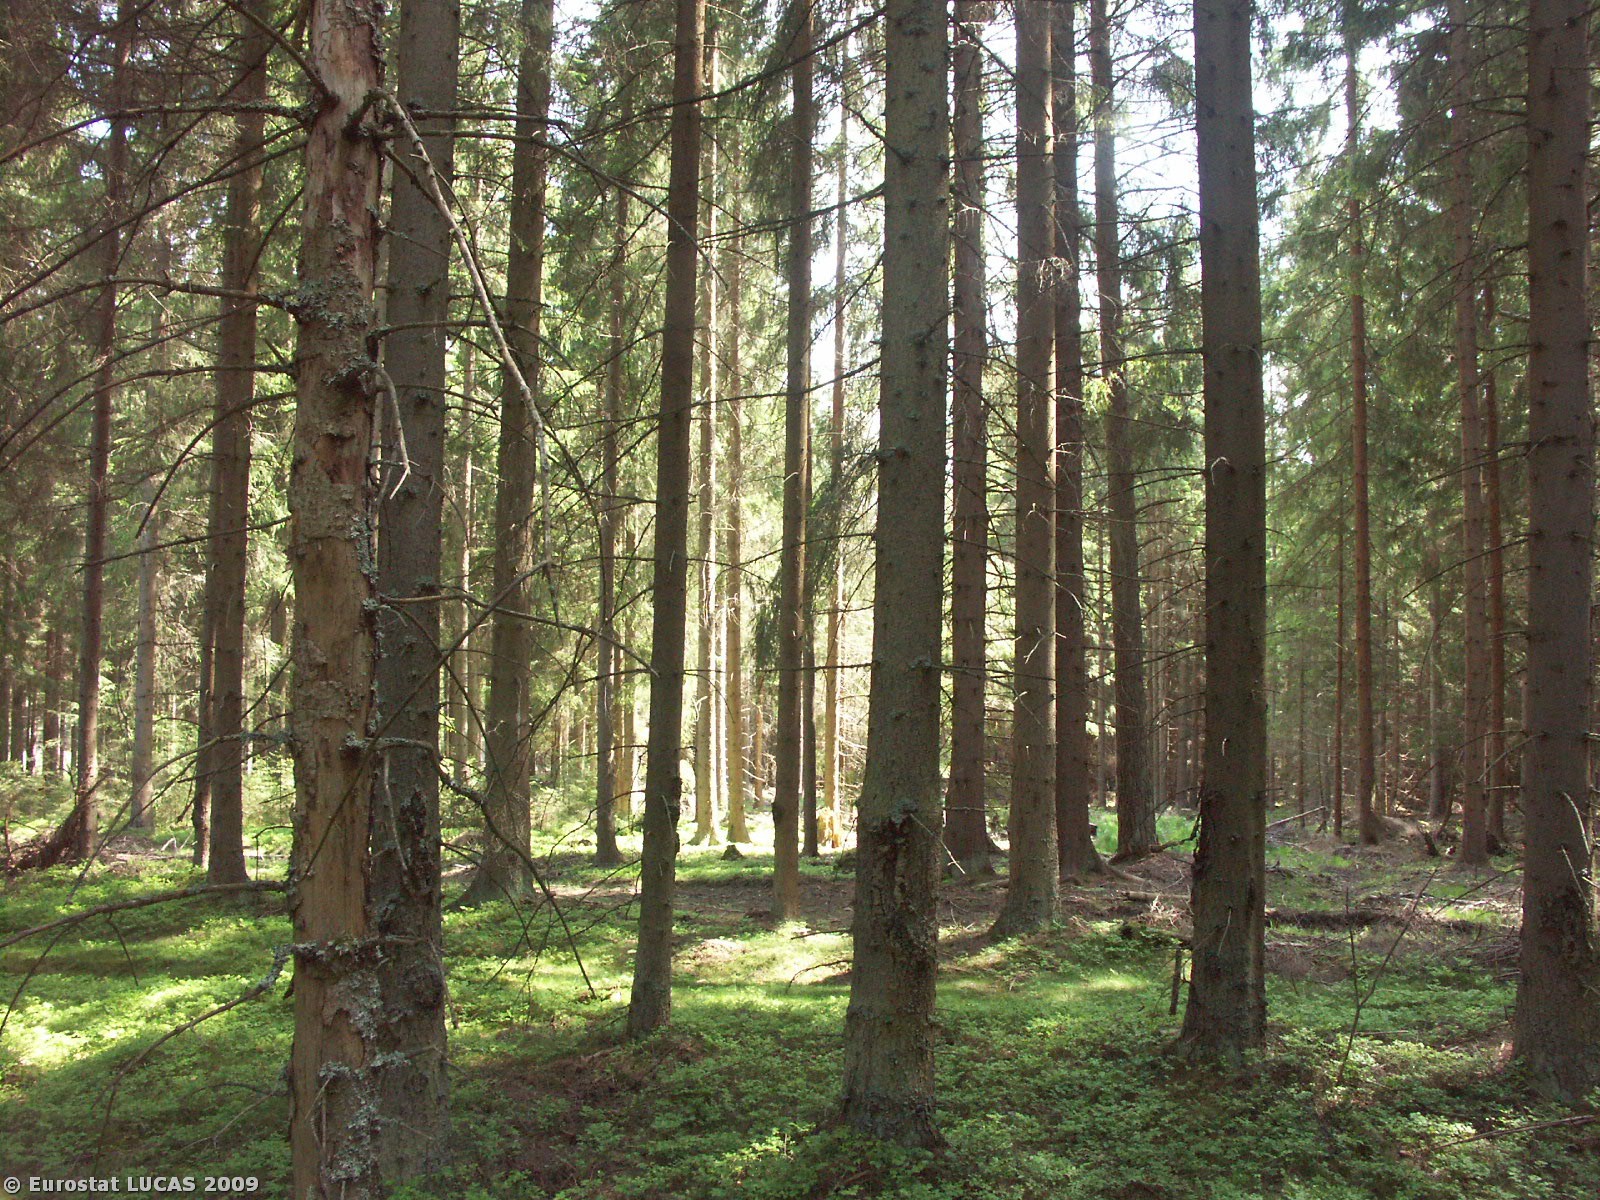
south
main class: Woodland
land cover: Coniferous woodland
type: hemiboreal forest and nemoral coniferous forest and mixed broadleaved-coniferous forest
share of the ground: > 75 %
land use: Forestry
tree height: > 5 m
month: May
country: CZ
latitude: 48.6490
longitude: 14.6296
